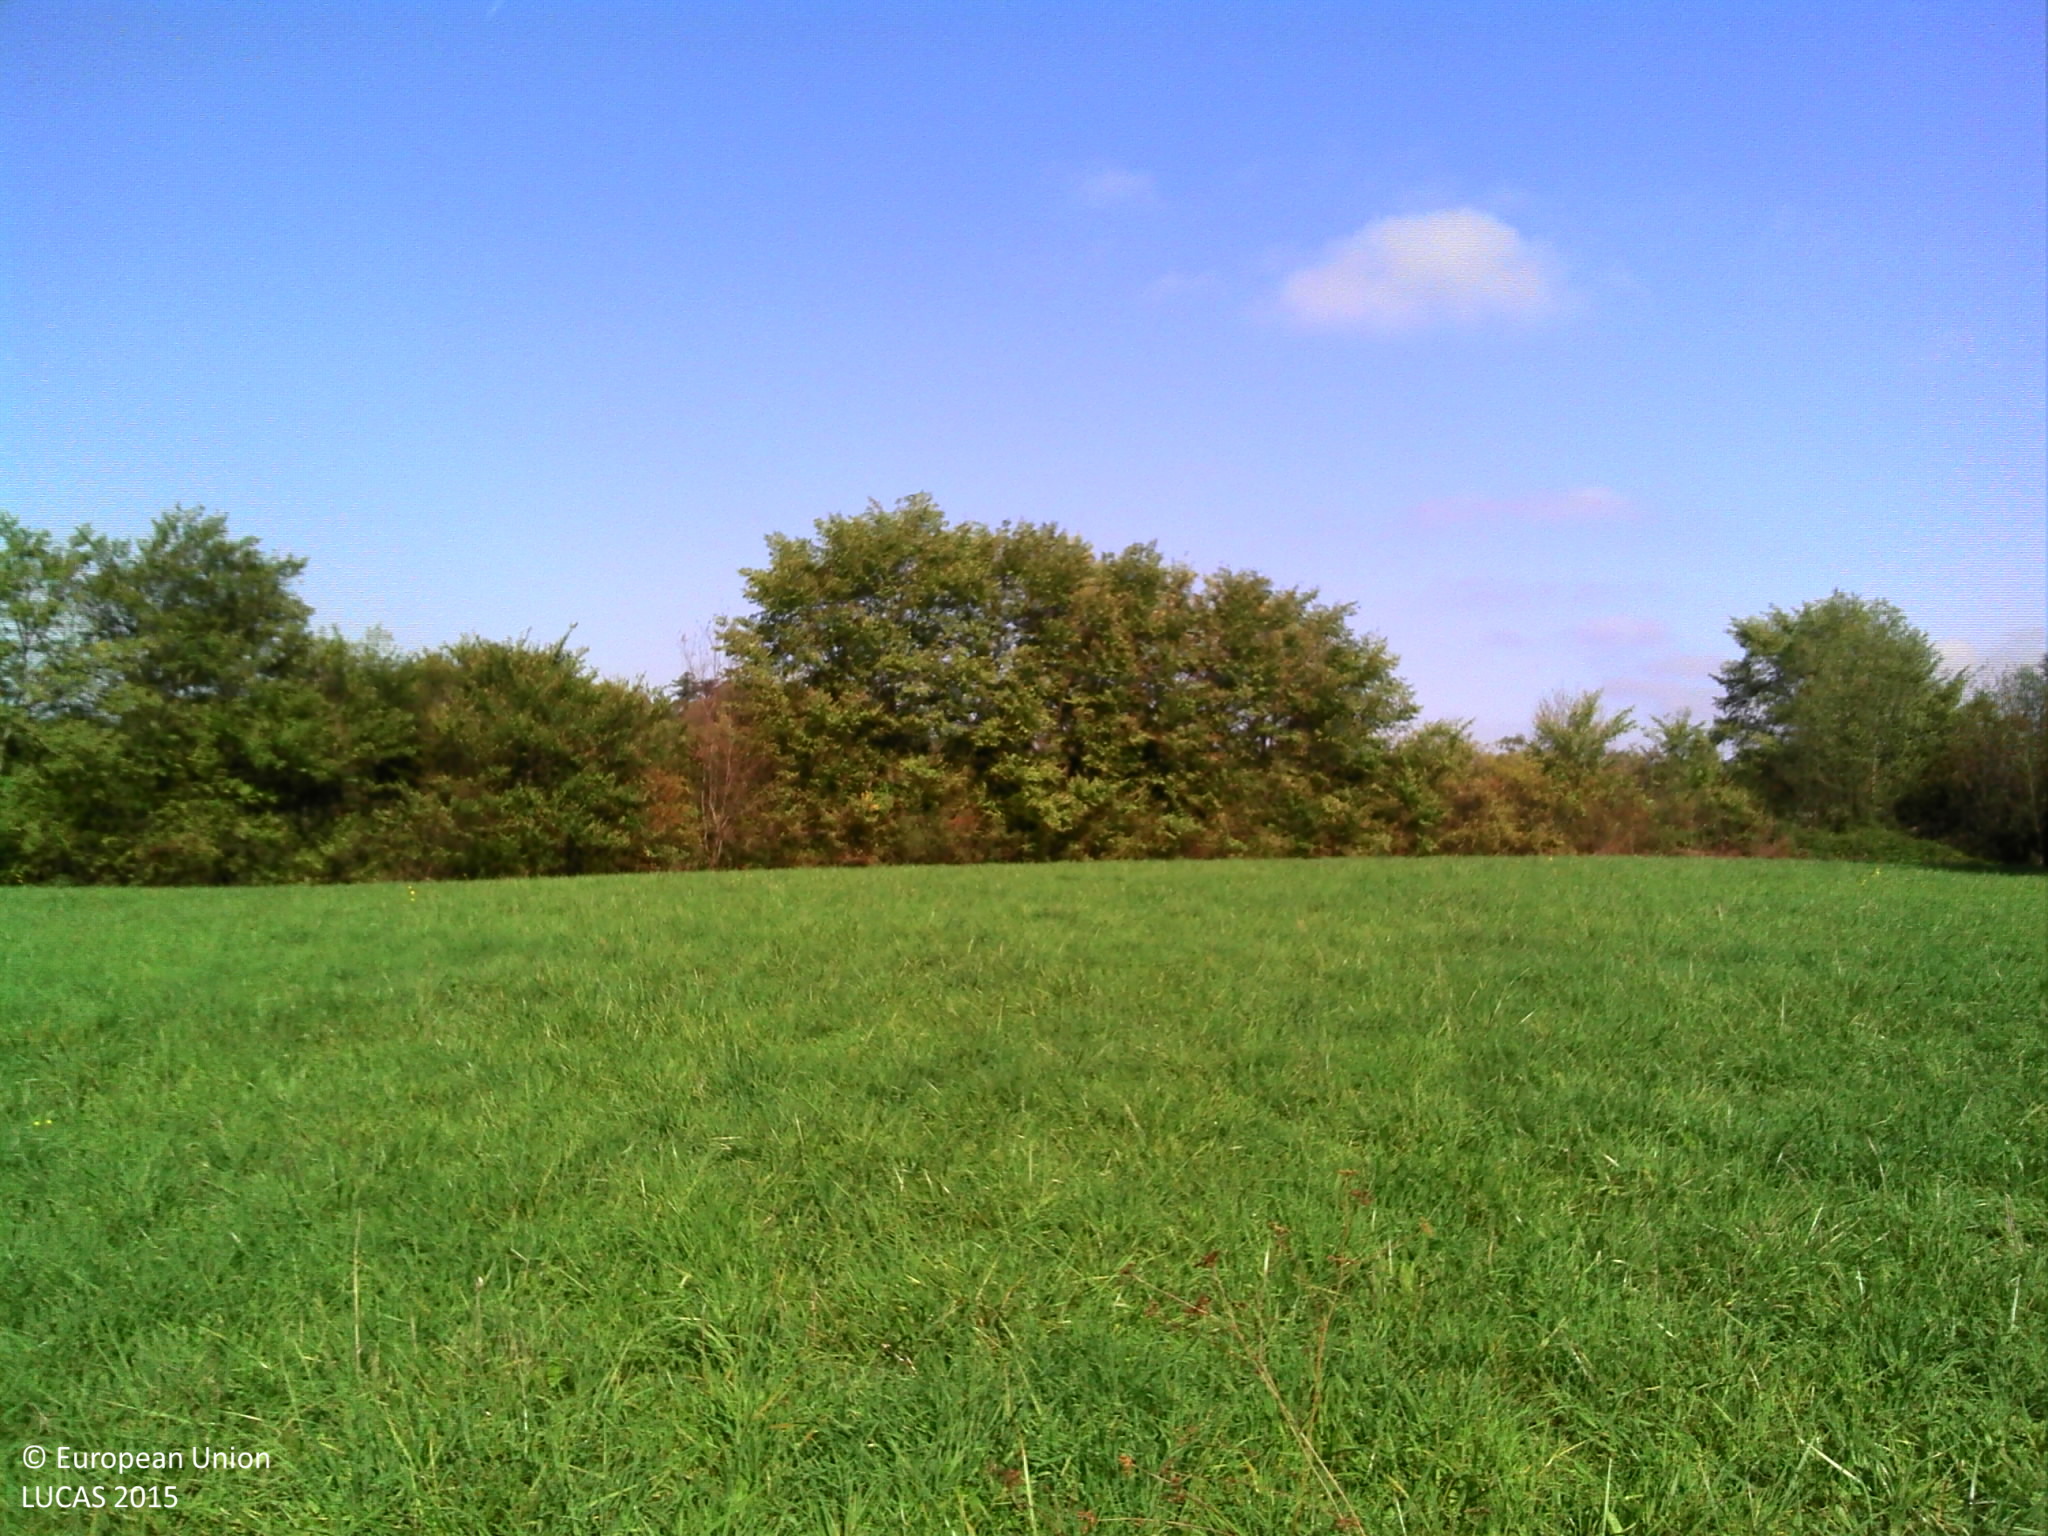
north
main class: Grassland
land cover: Grassland without tree/shrub cover
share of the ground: > 75 %
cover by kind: herbaceous plants 100 %
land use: Agriculture (excluding fallow land and kitchen gardens)
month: October
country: FR
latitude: 46.2838
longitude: 4.9017
